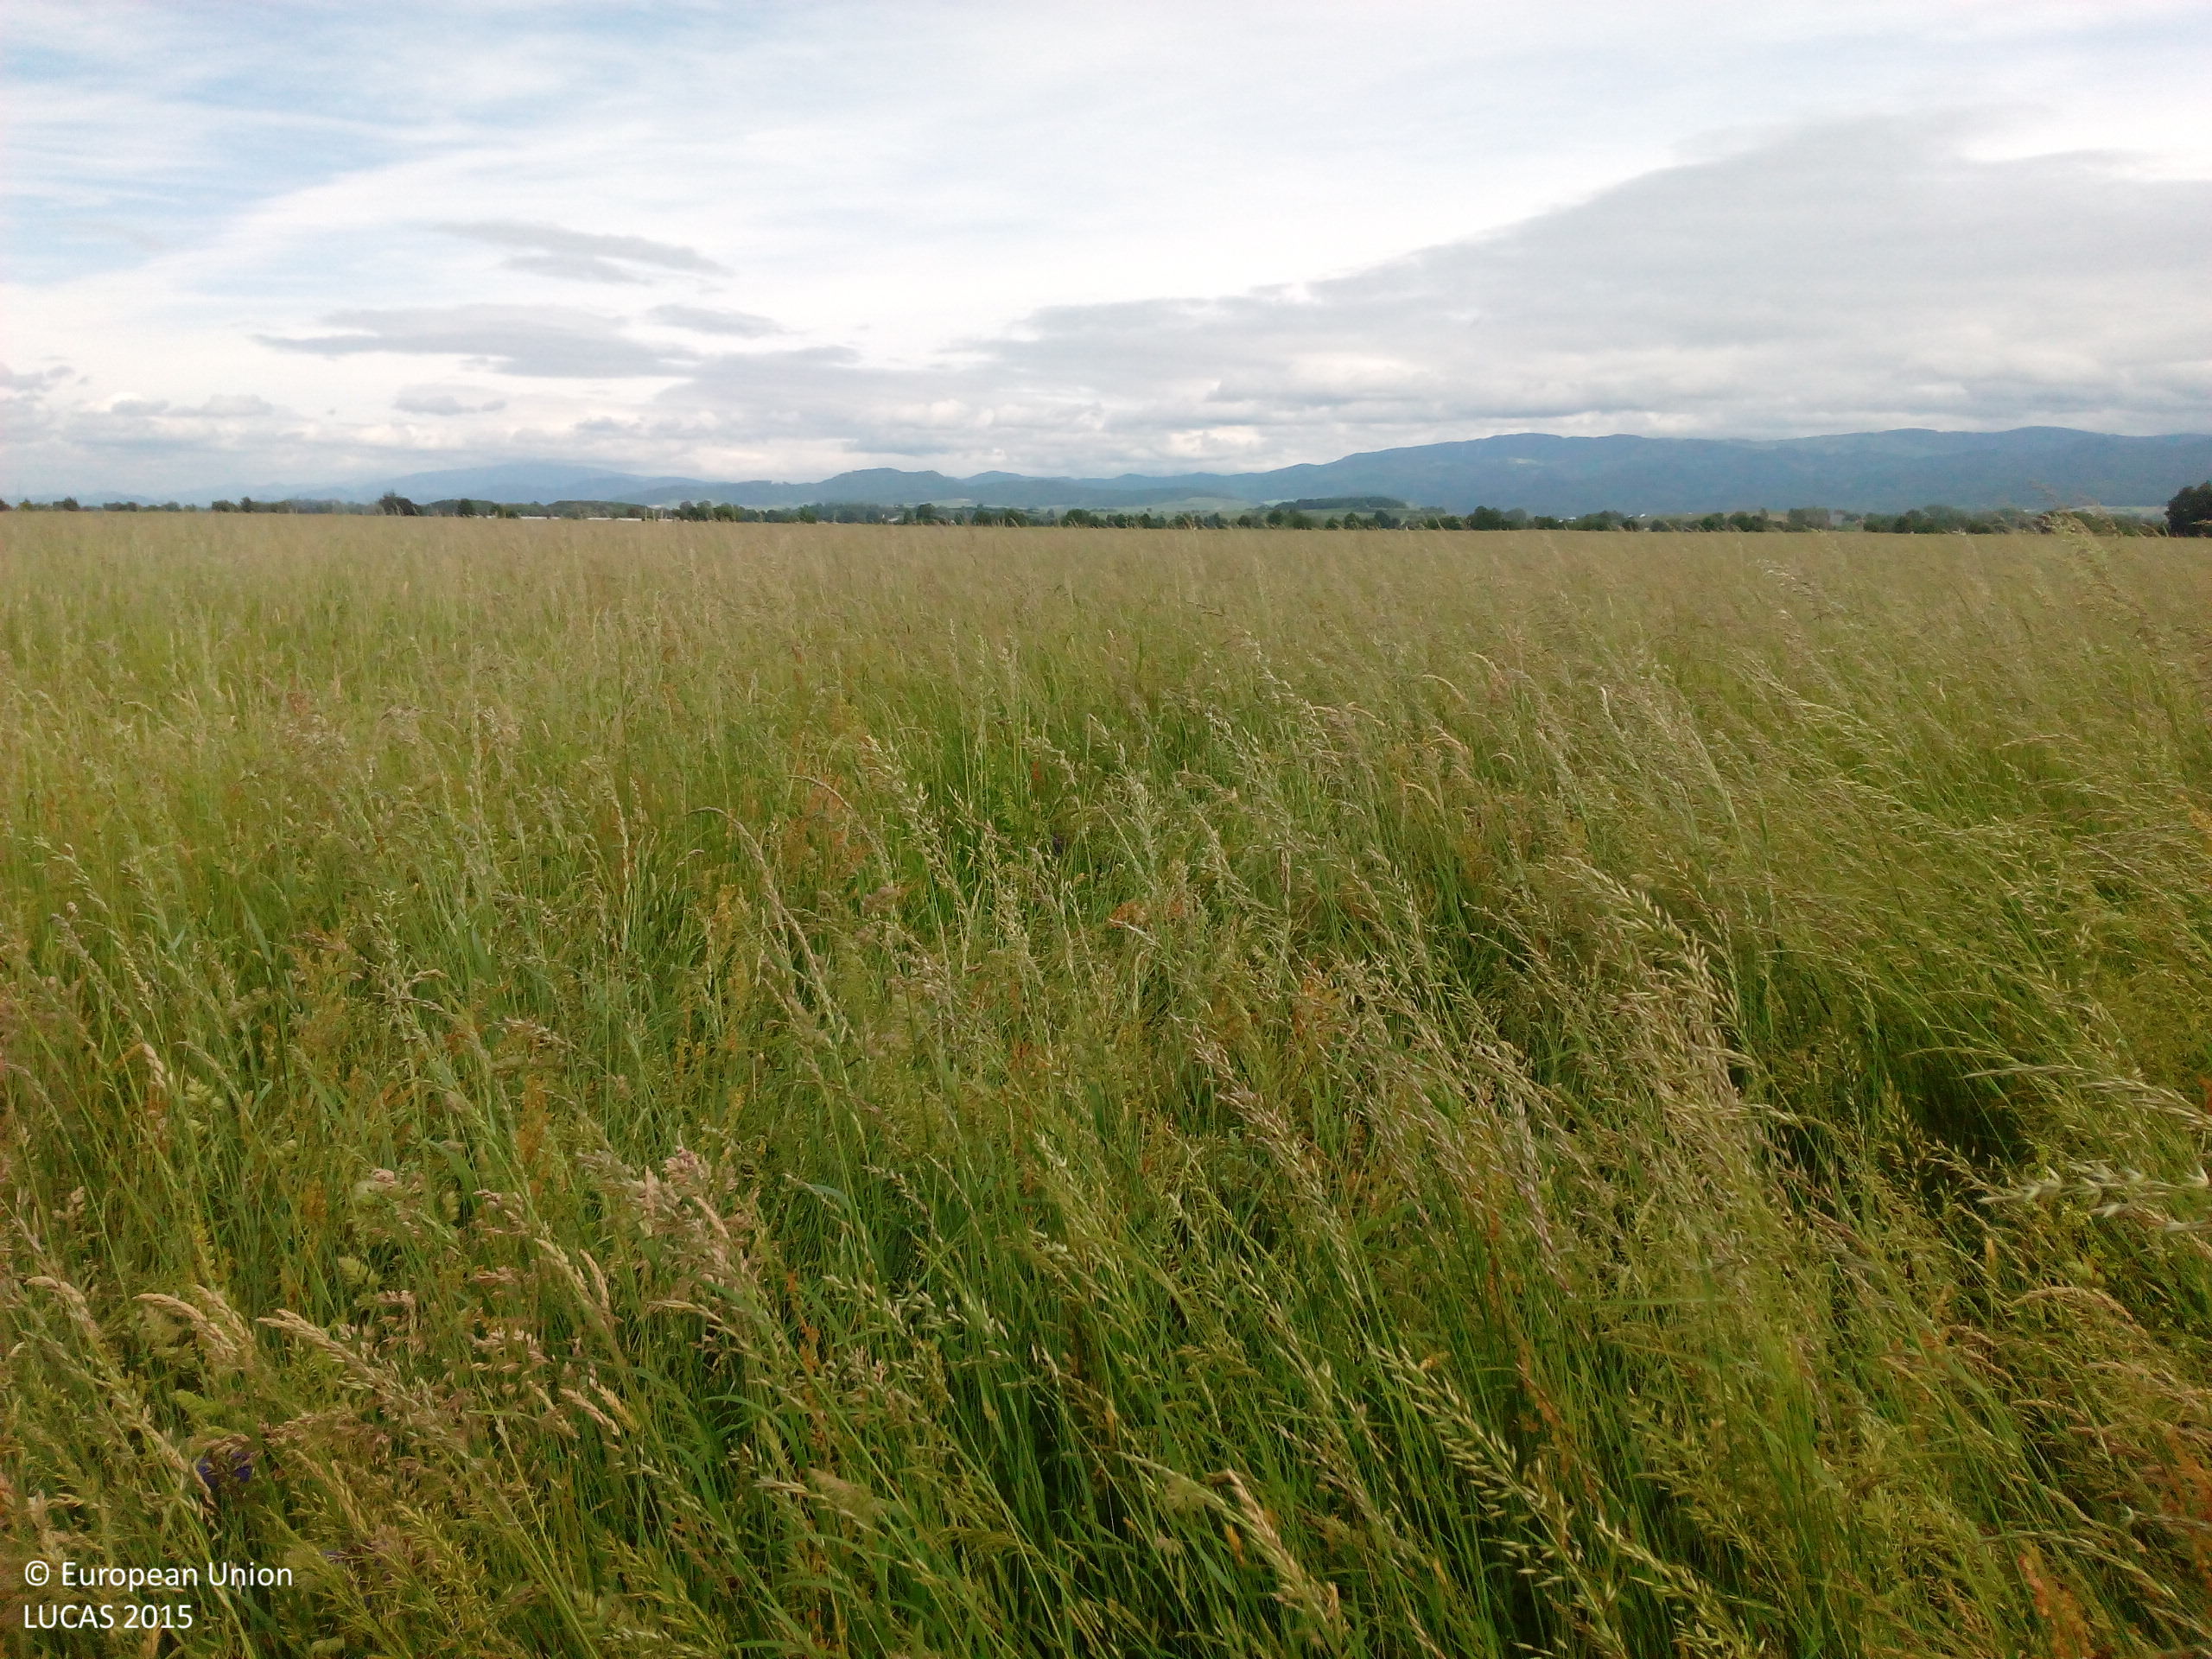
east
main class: Grassland
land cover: Grassland without tree/shrub cover
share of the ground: > 75 %
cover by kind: herbaceous plants 100 %
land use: Air transport
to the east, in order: Grassland without tree/shrub cover
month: May
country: DE
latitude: 47.9101
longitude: 7.6331
